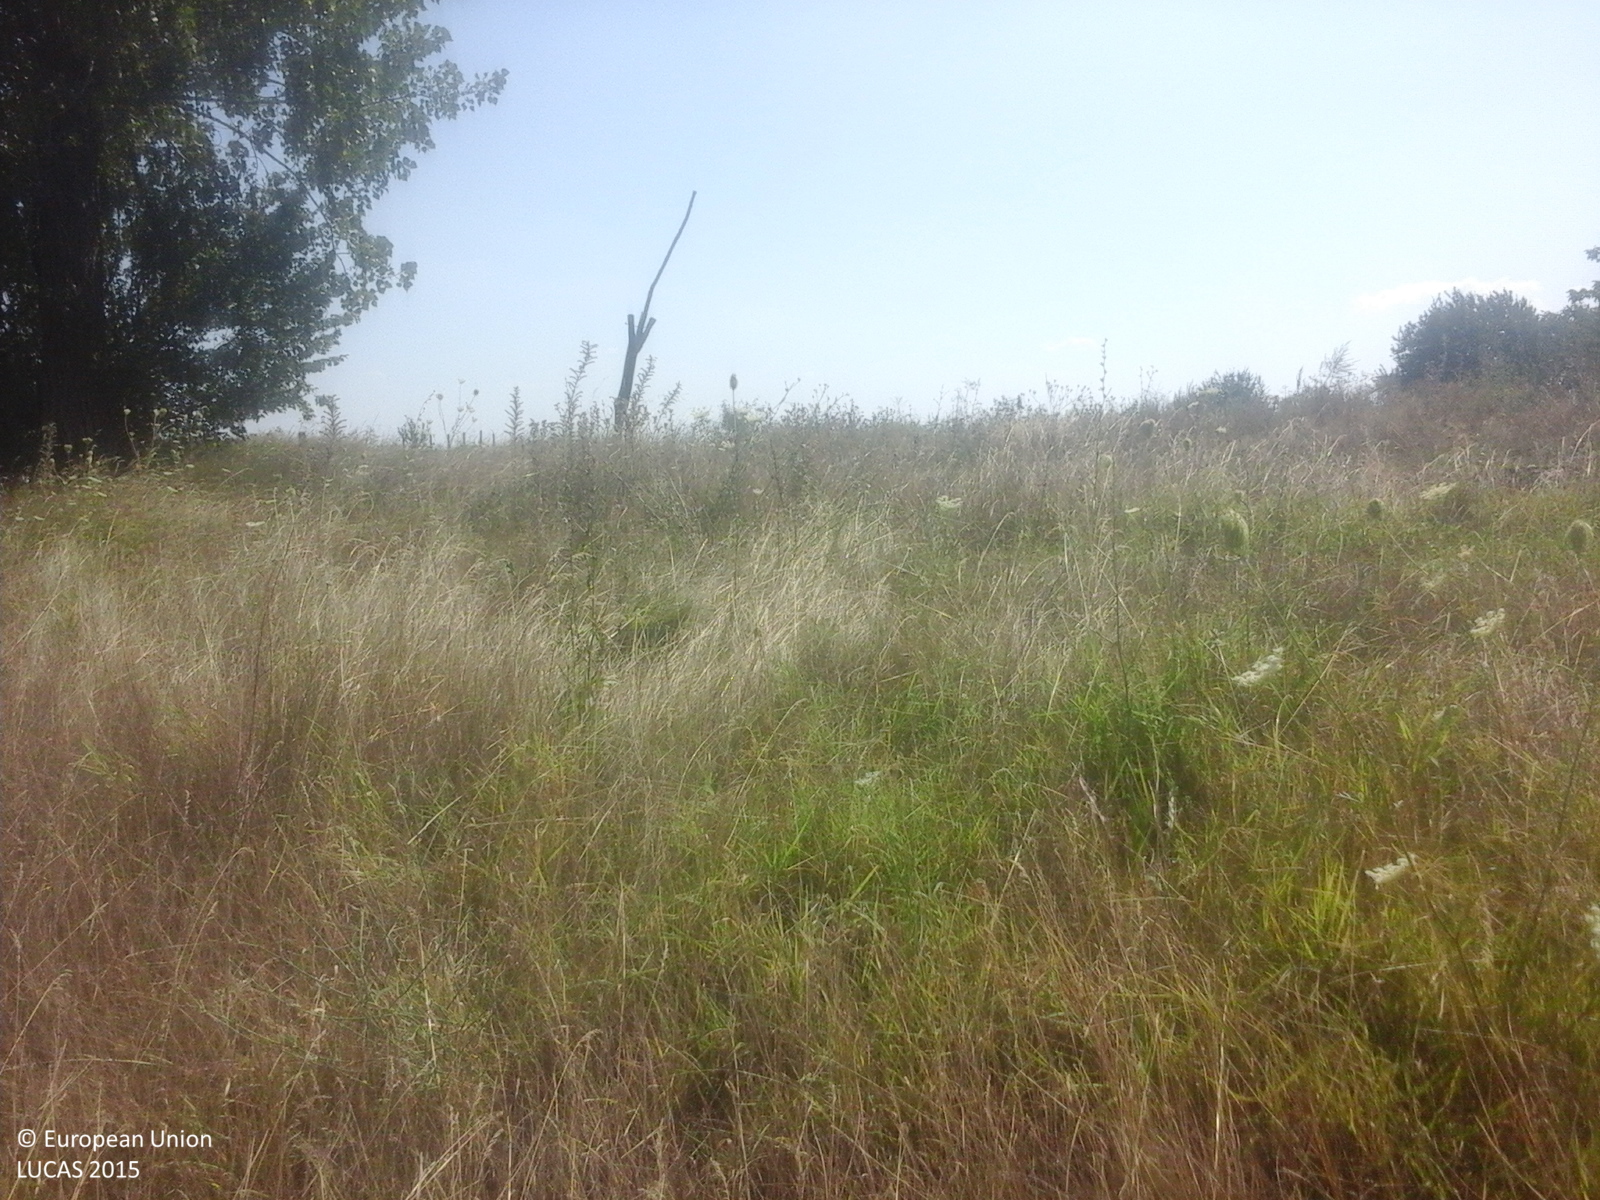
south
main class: Cropland
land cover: Maize
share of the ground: > 75 %
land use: Agriculture (excluding fallow land and kitchen gardens)
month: August
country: RO
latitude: 45.0699
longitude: 26.8847
